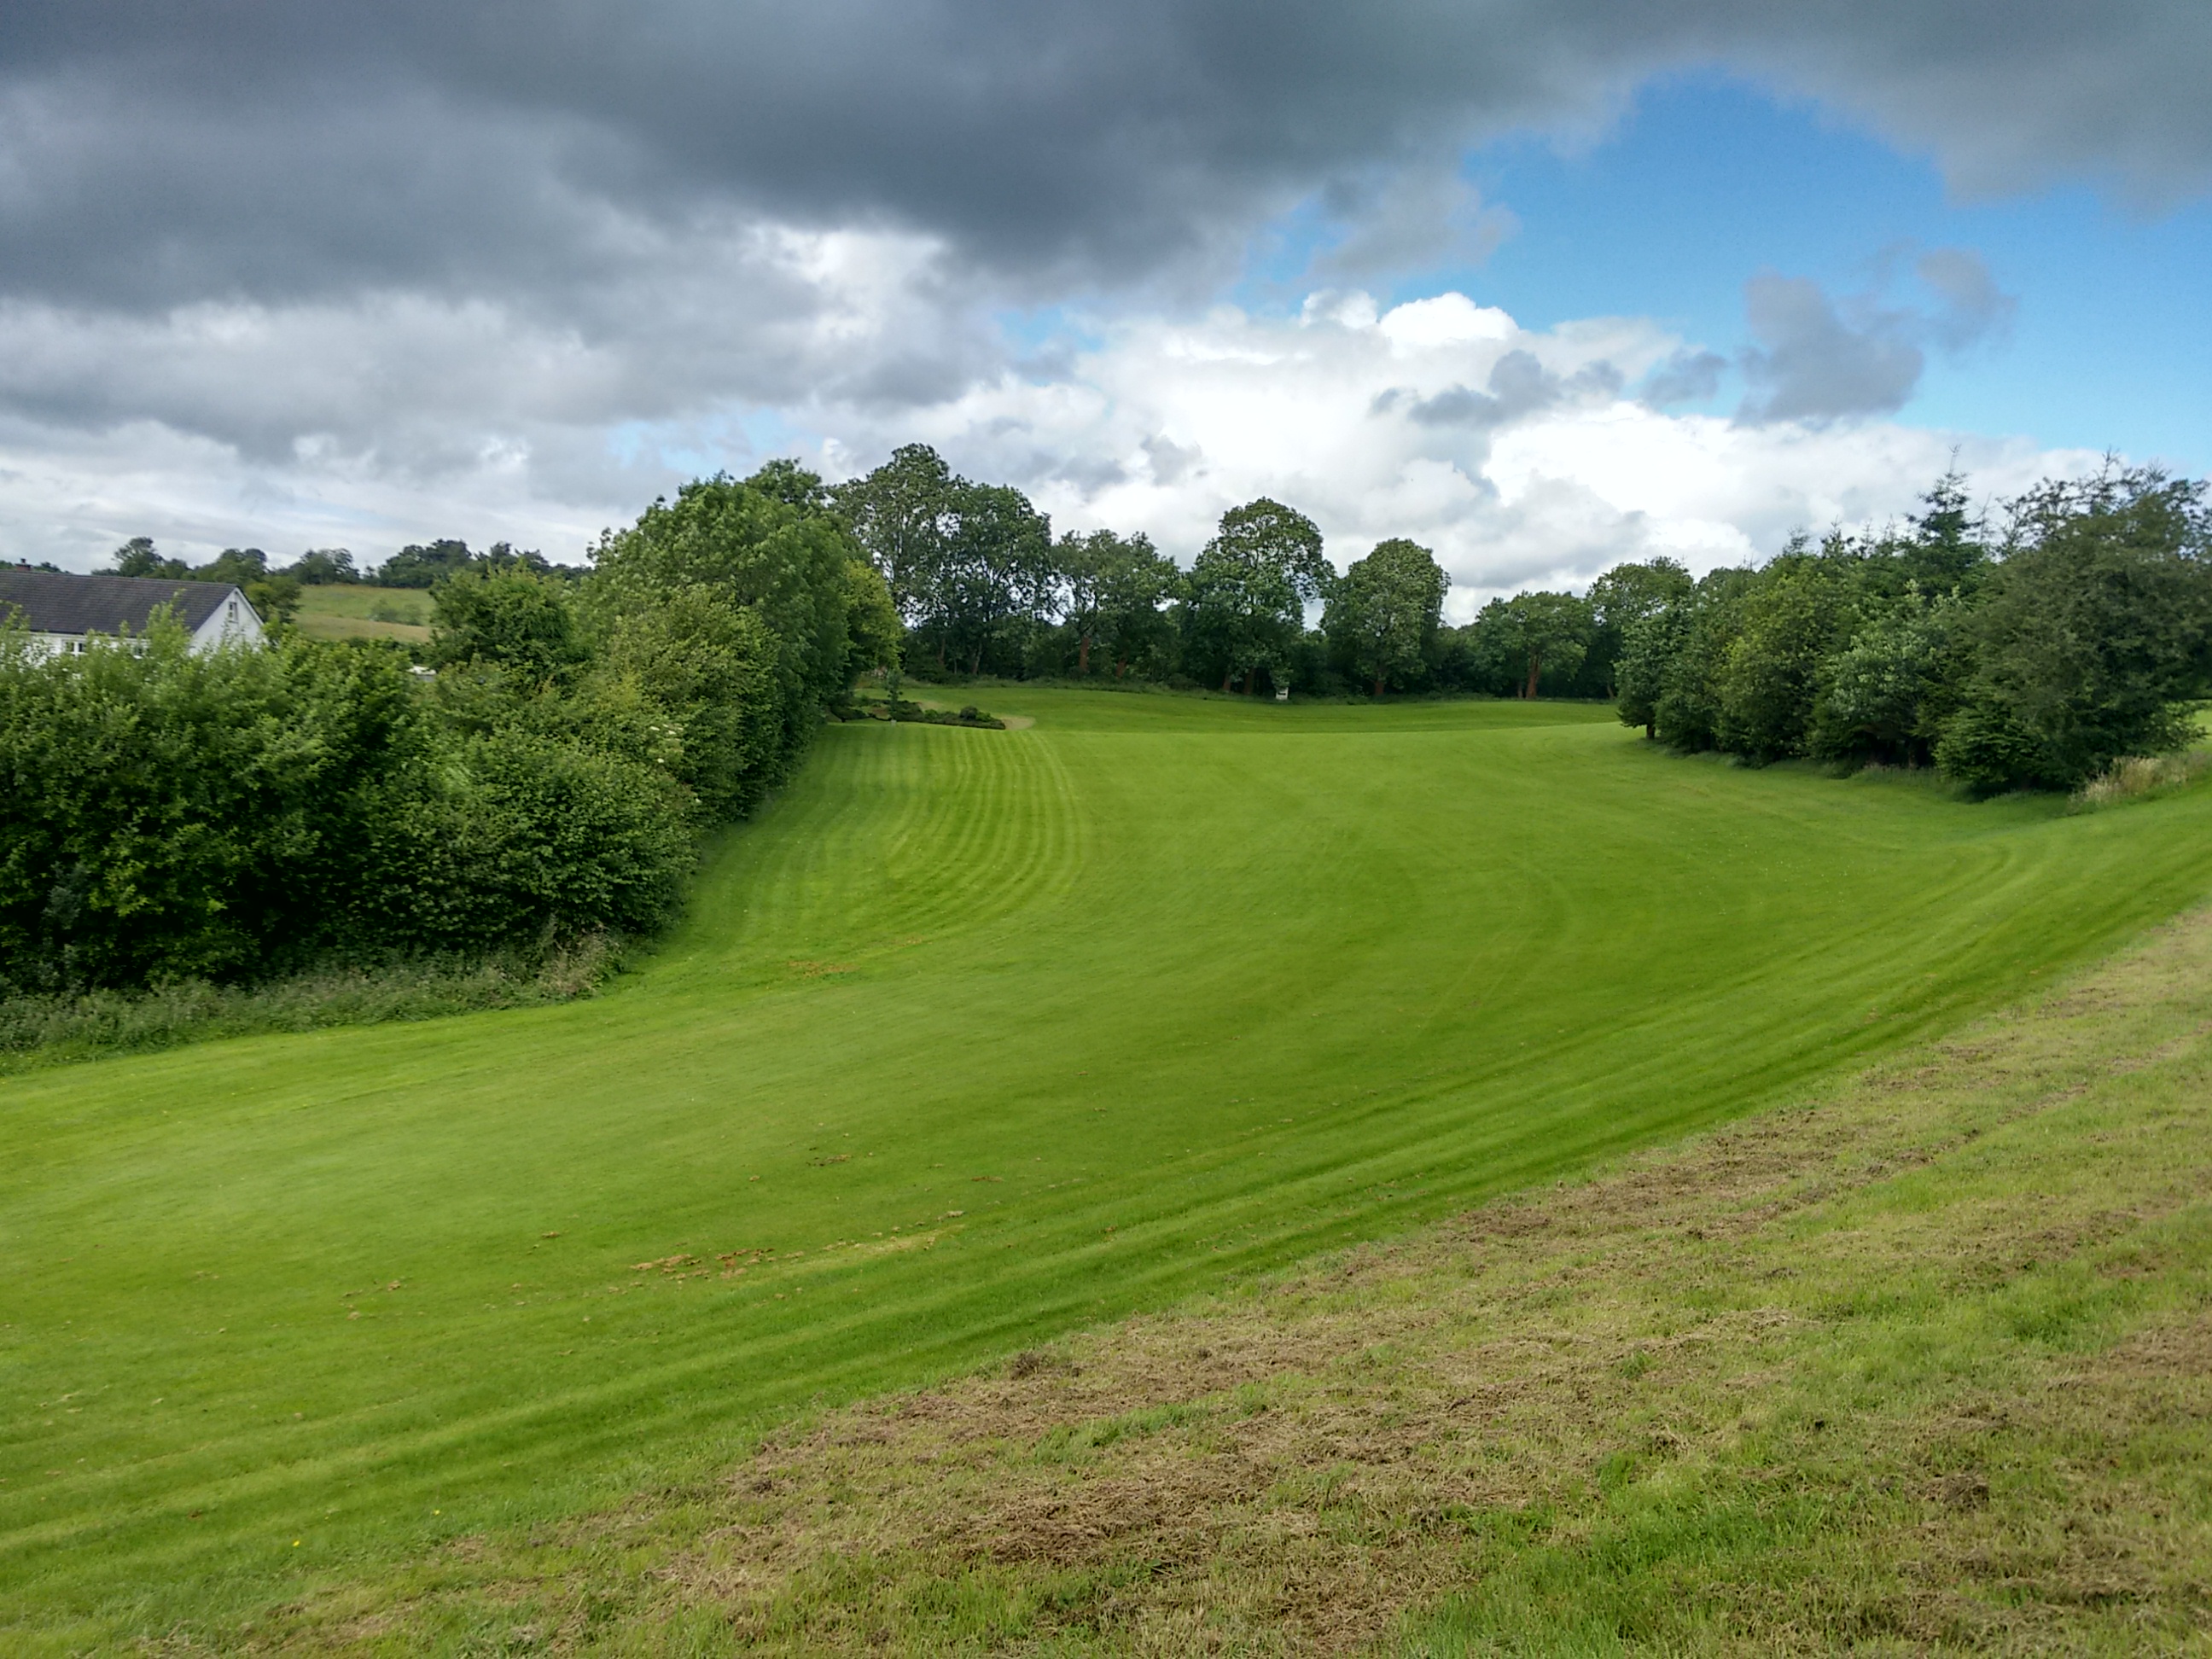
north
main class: Grassland
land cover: Grassland with sparse tree/shrub cover
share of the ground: > 75 %
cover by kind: herbaceous plants 95 %, coniferous forest trees 5 %
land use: Sport
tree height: > 5 m
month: July
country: GB
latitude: 54.3657
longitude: -7.3426
